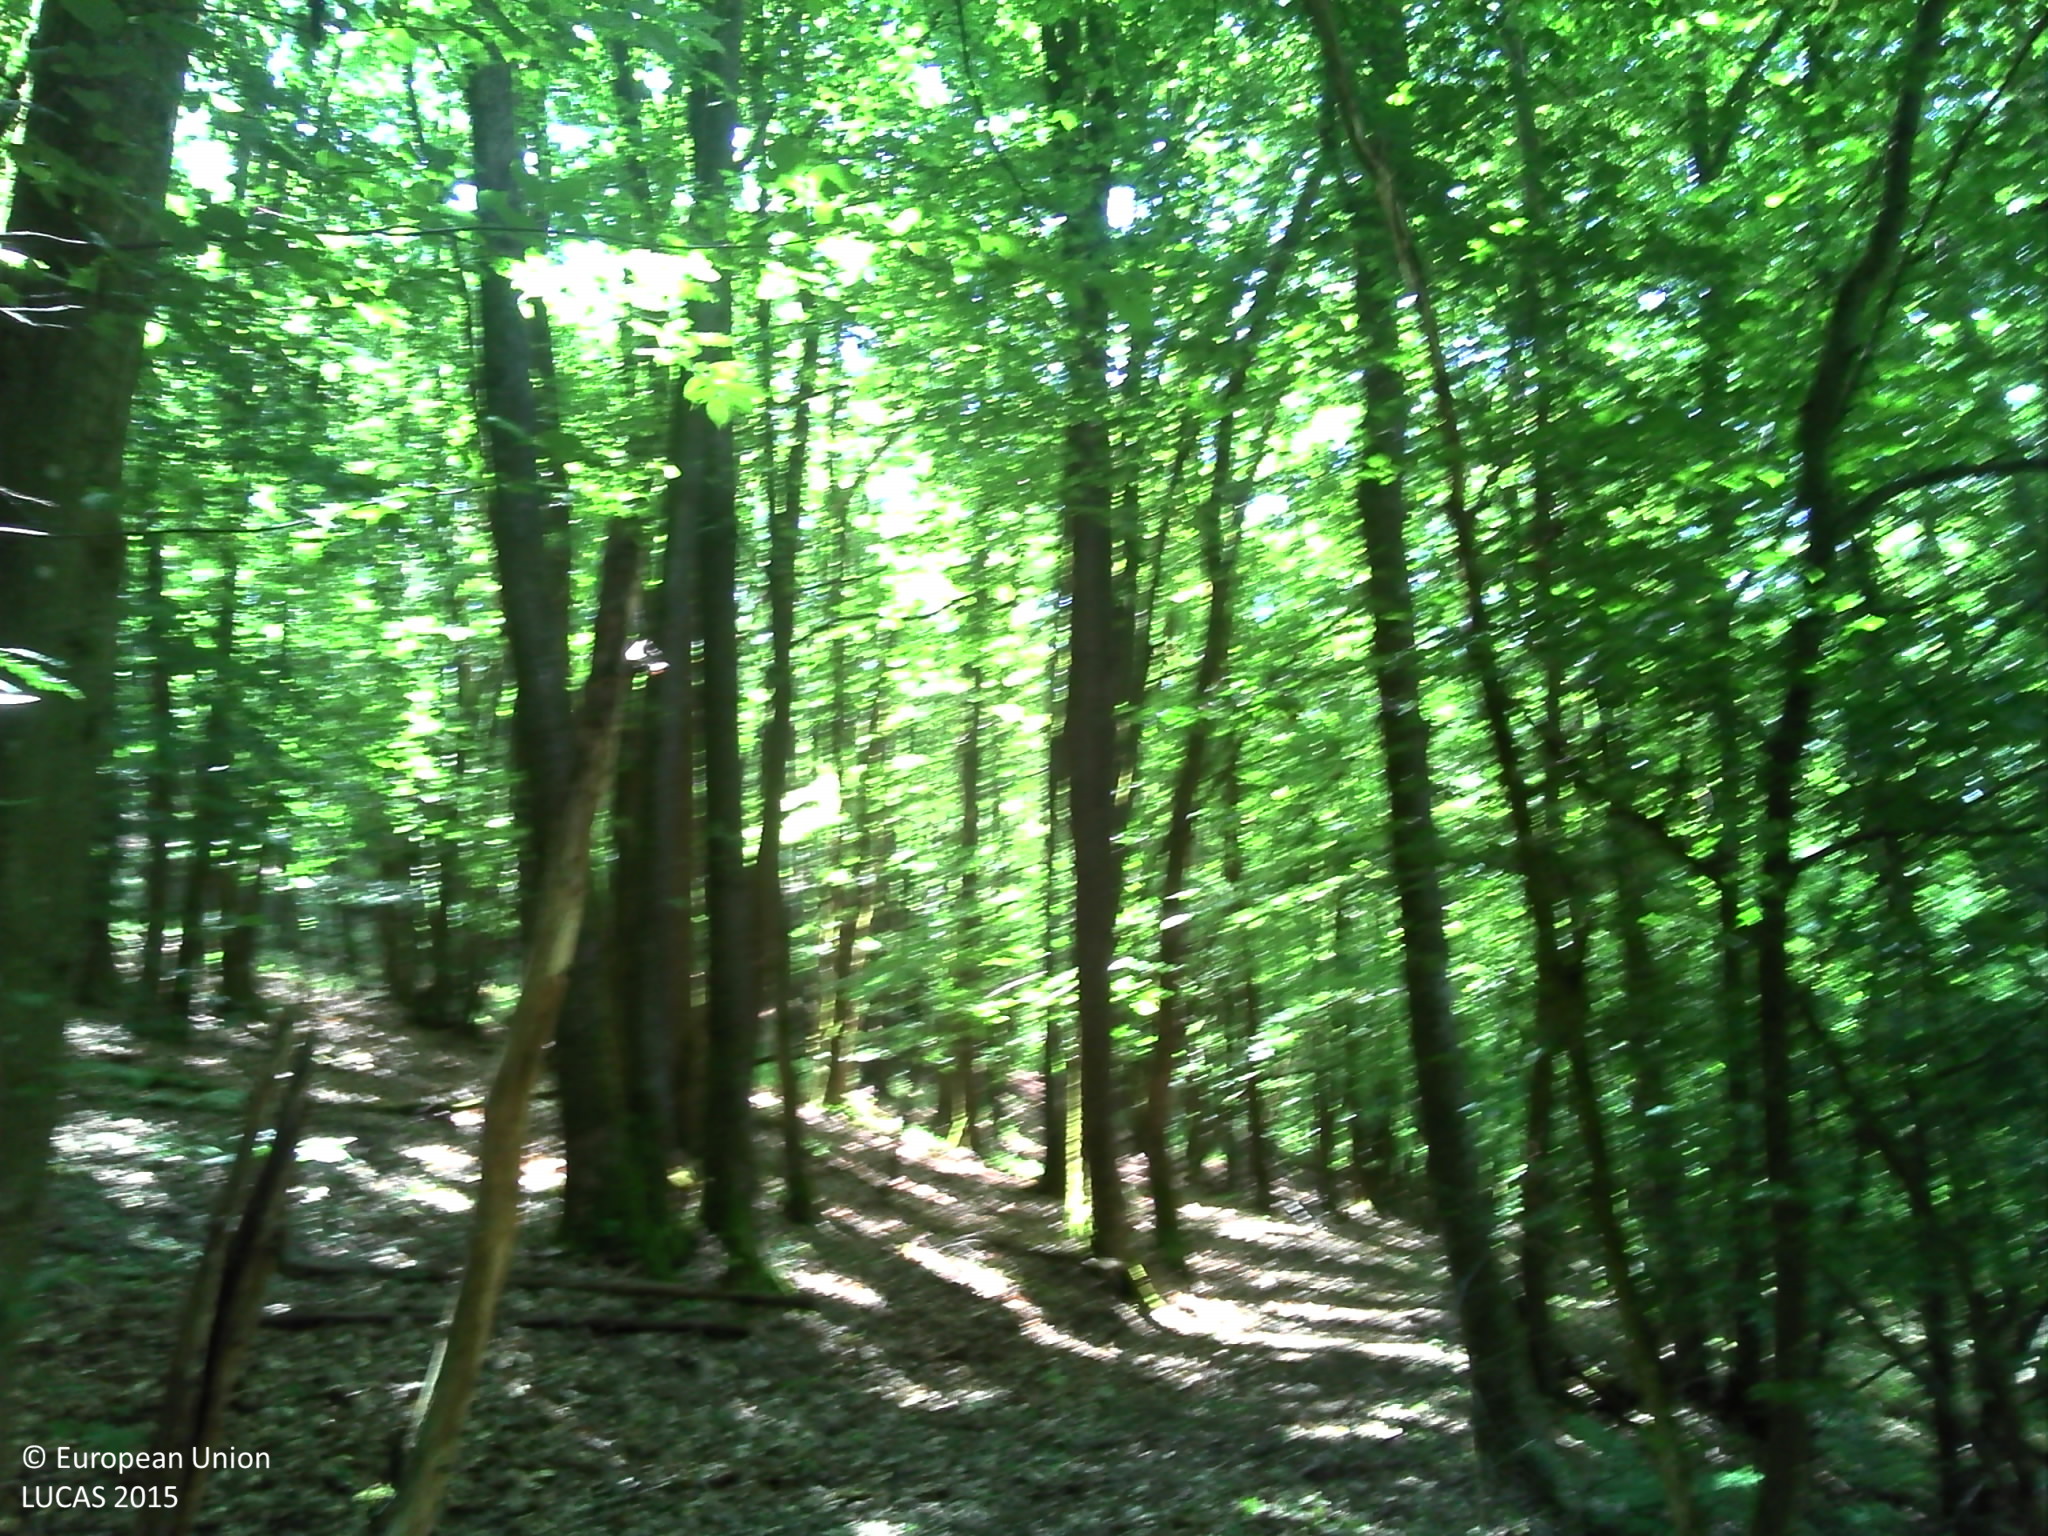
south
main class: Woodland
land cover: Broadleaved woodland
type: mesophytic deciduous forest
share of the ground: > 75 %
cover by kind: broadleaved forest trees 90 %, herbaceous plants 5 %, lichens and mosses 5 %
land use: Forestry
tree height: > 5 m
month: June
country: LU
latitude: 49.9729
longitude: 6.0812
